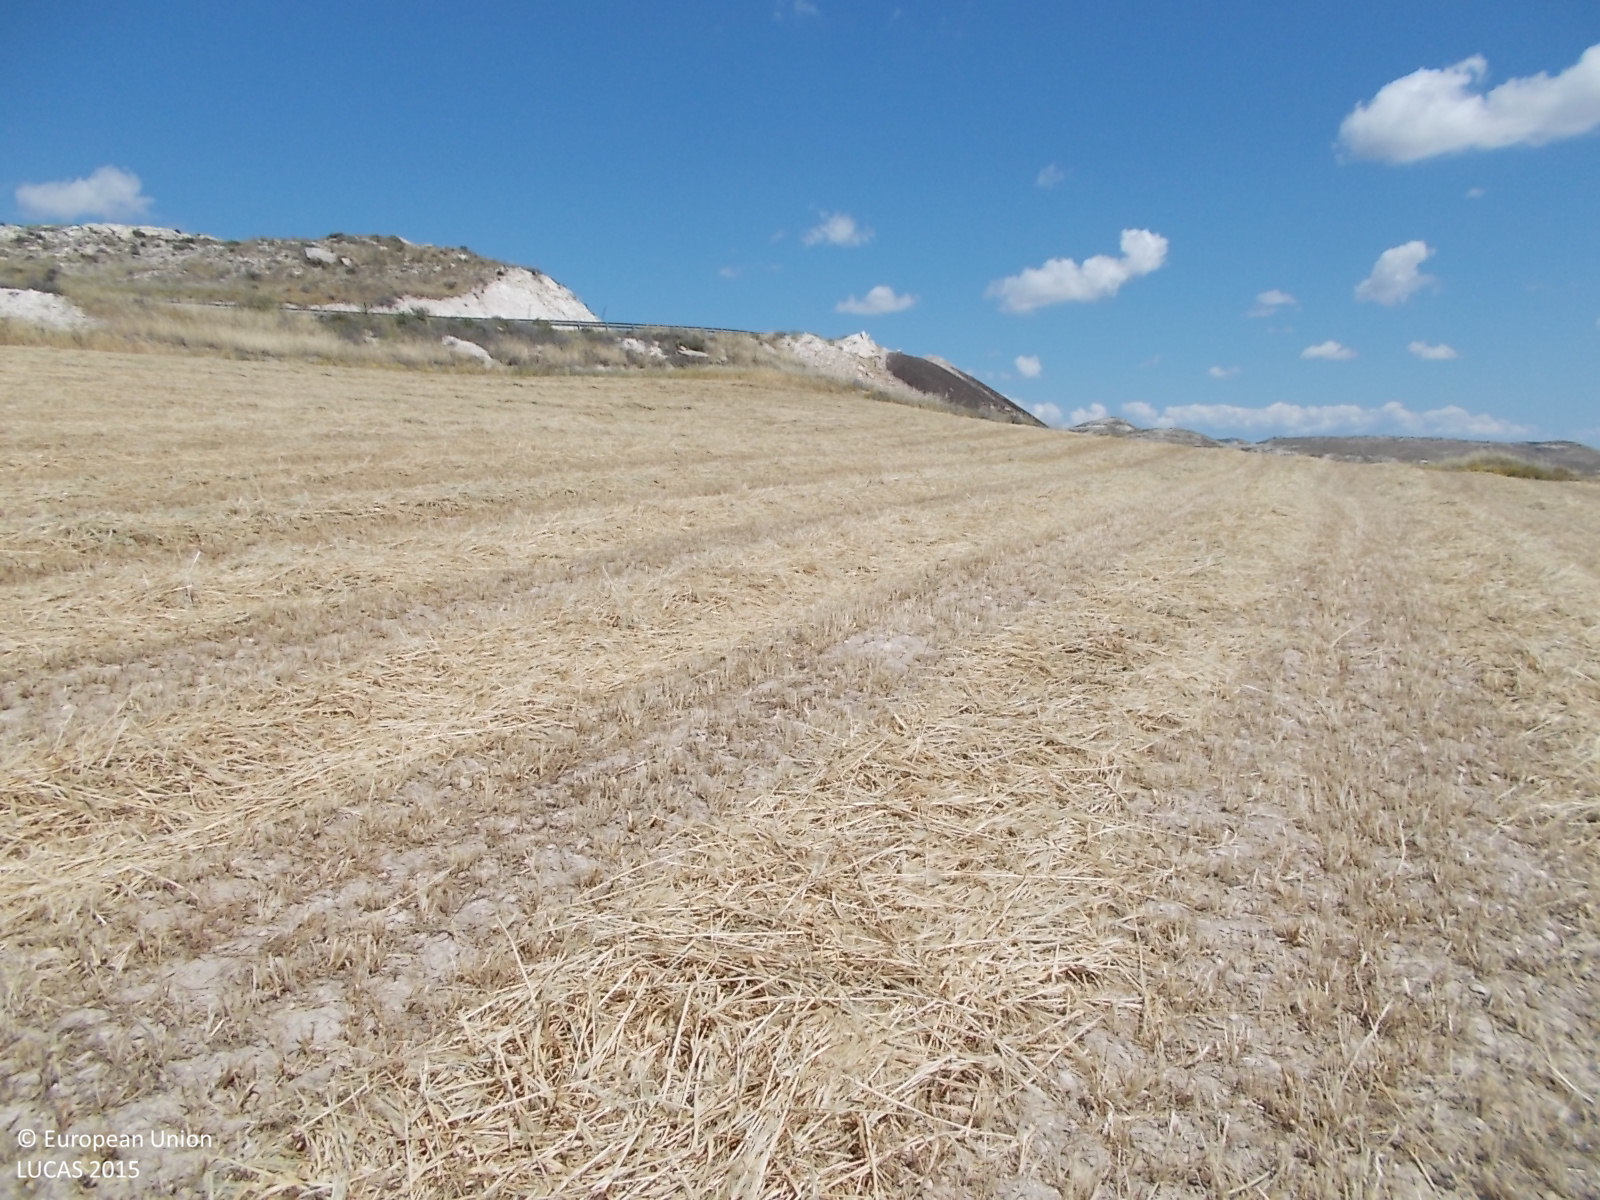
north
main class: Cropland
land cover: Mixed cereals for fodder
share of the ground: < 10 %
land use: Agriculture (excluding fallow land and kitchen gardens)
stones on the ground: < 10 %
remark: Harvested field
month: April
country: CY
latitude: 35.0207
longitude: 33.5744
